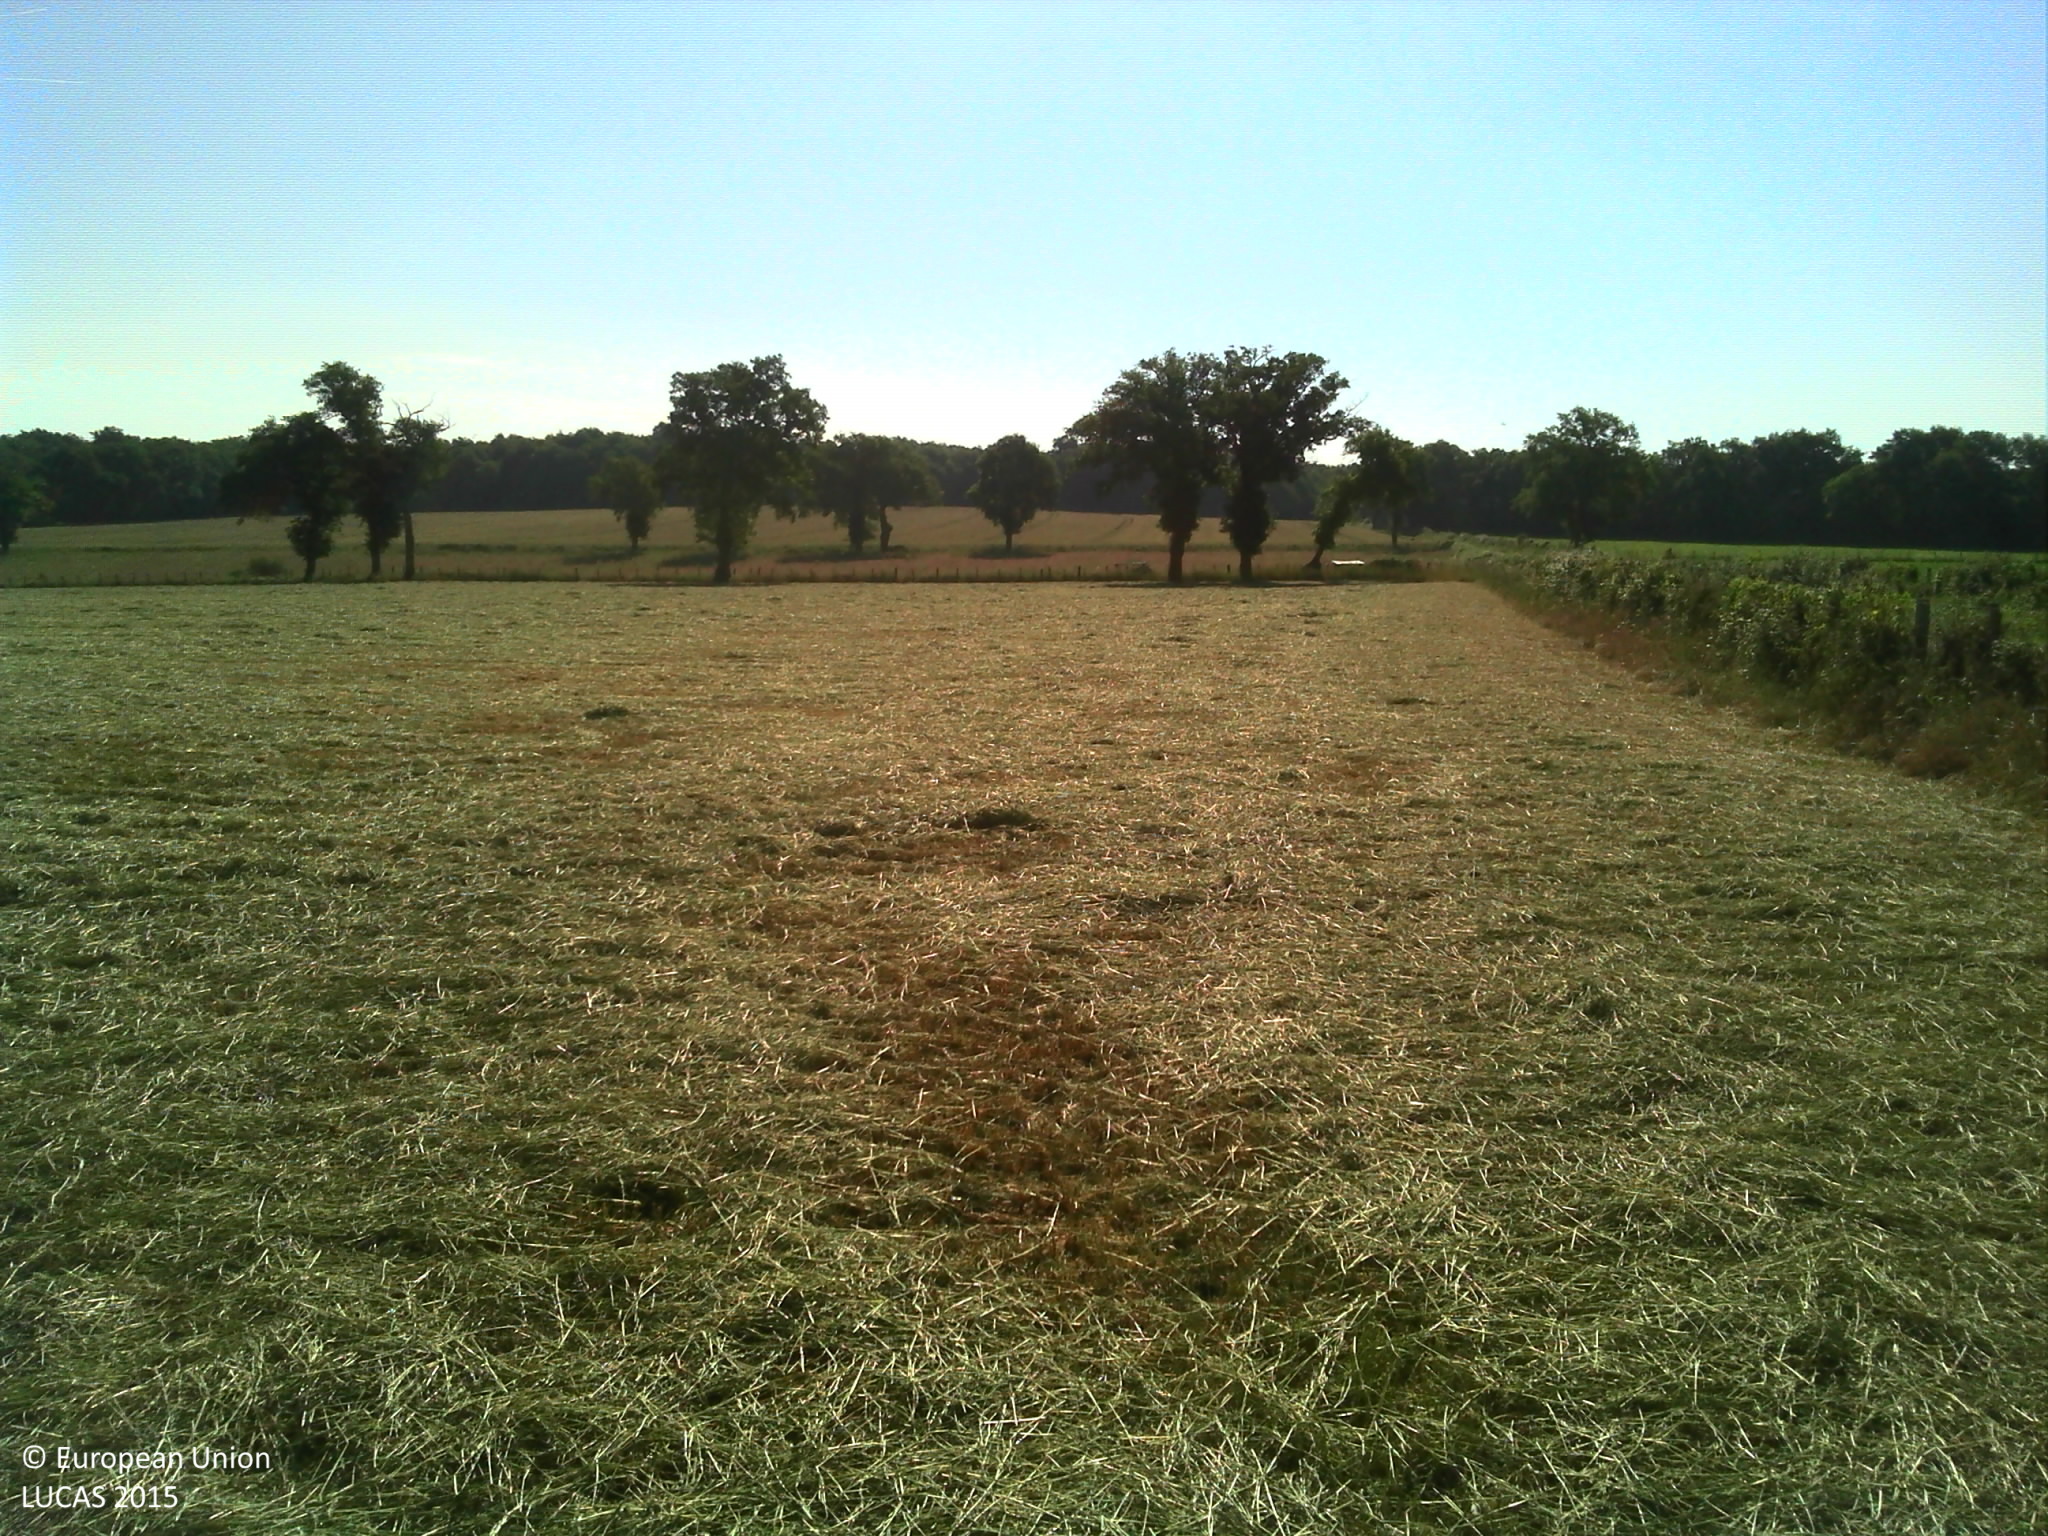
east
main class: Grassland
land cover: Grassland without tree/shrub cover
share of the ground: > 75 %
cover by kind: herbaceous plants 100 %
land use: Agriculture (excluding fallow land and kitchen gardens)
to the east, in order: Grassland without tree/shrub cover; Single bushes/trees; Fences; Grassland without tree/shrub cover
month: June
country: FR
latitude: 46.0421
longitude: 0.5647
